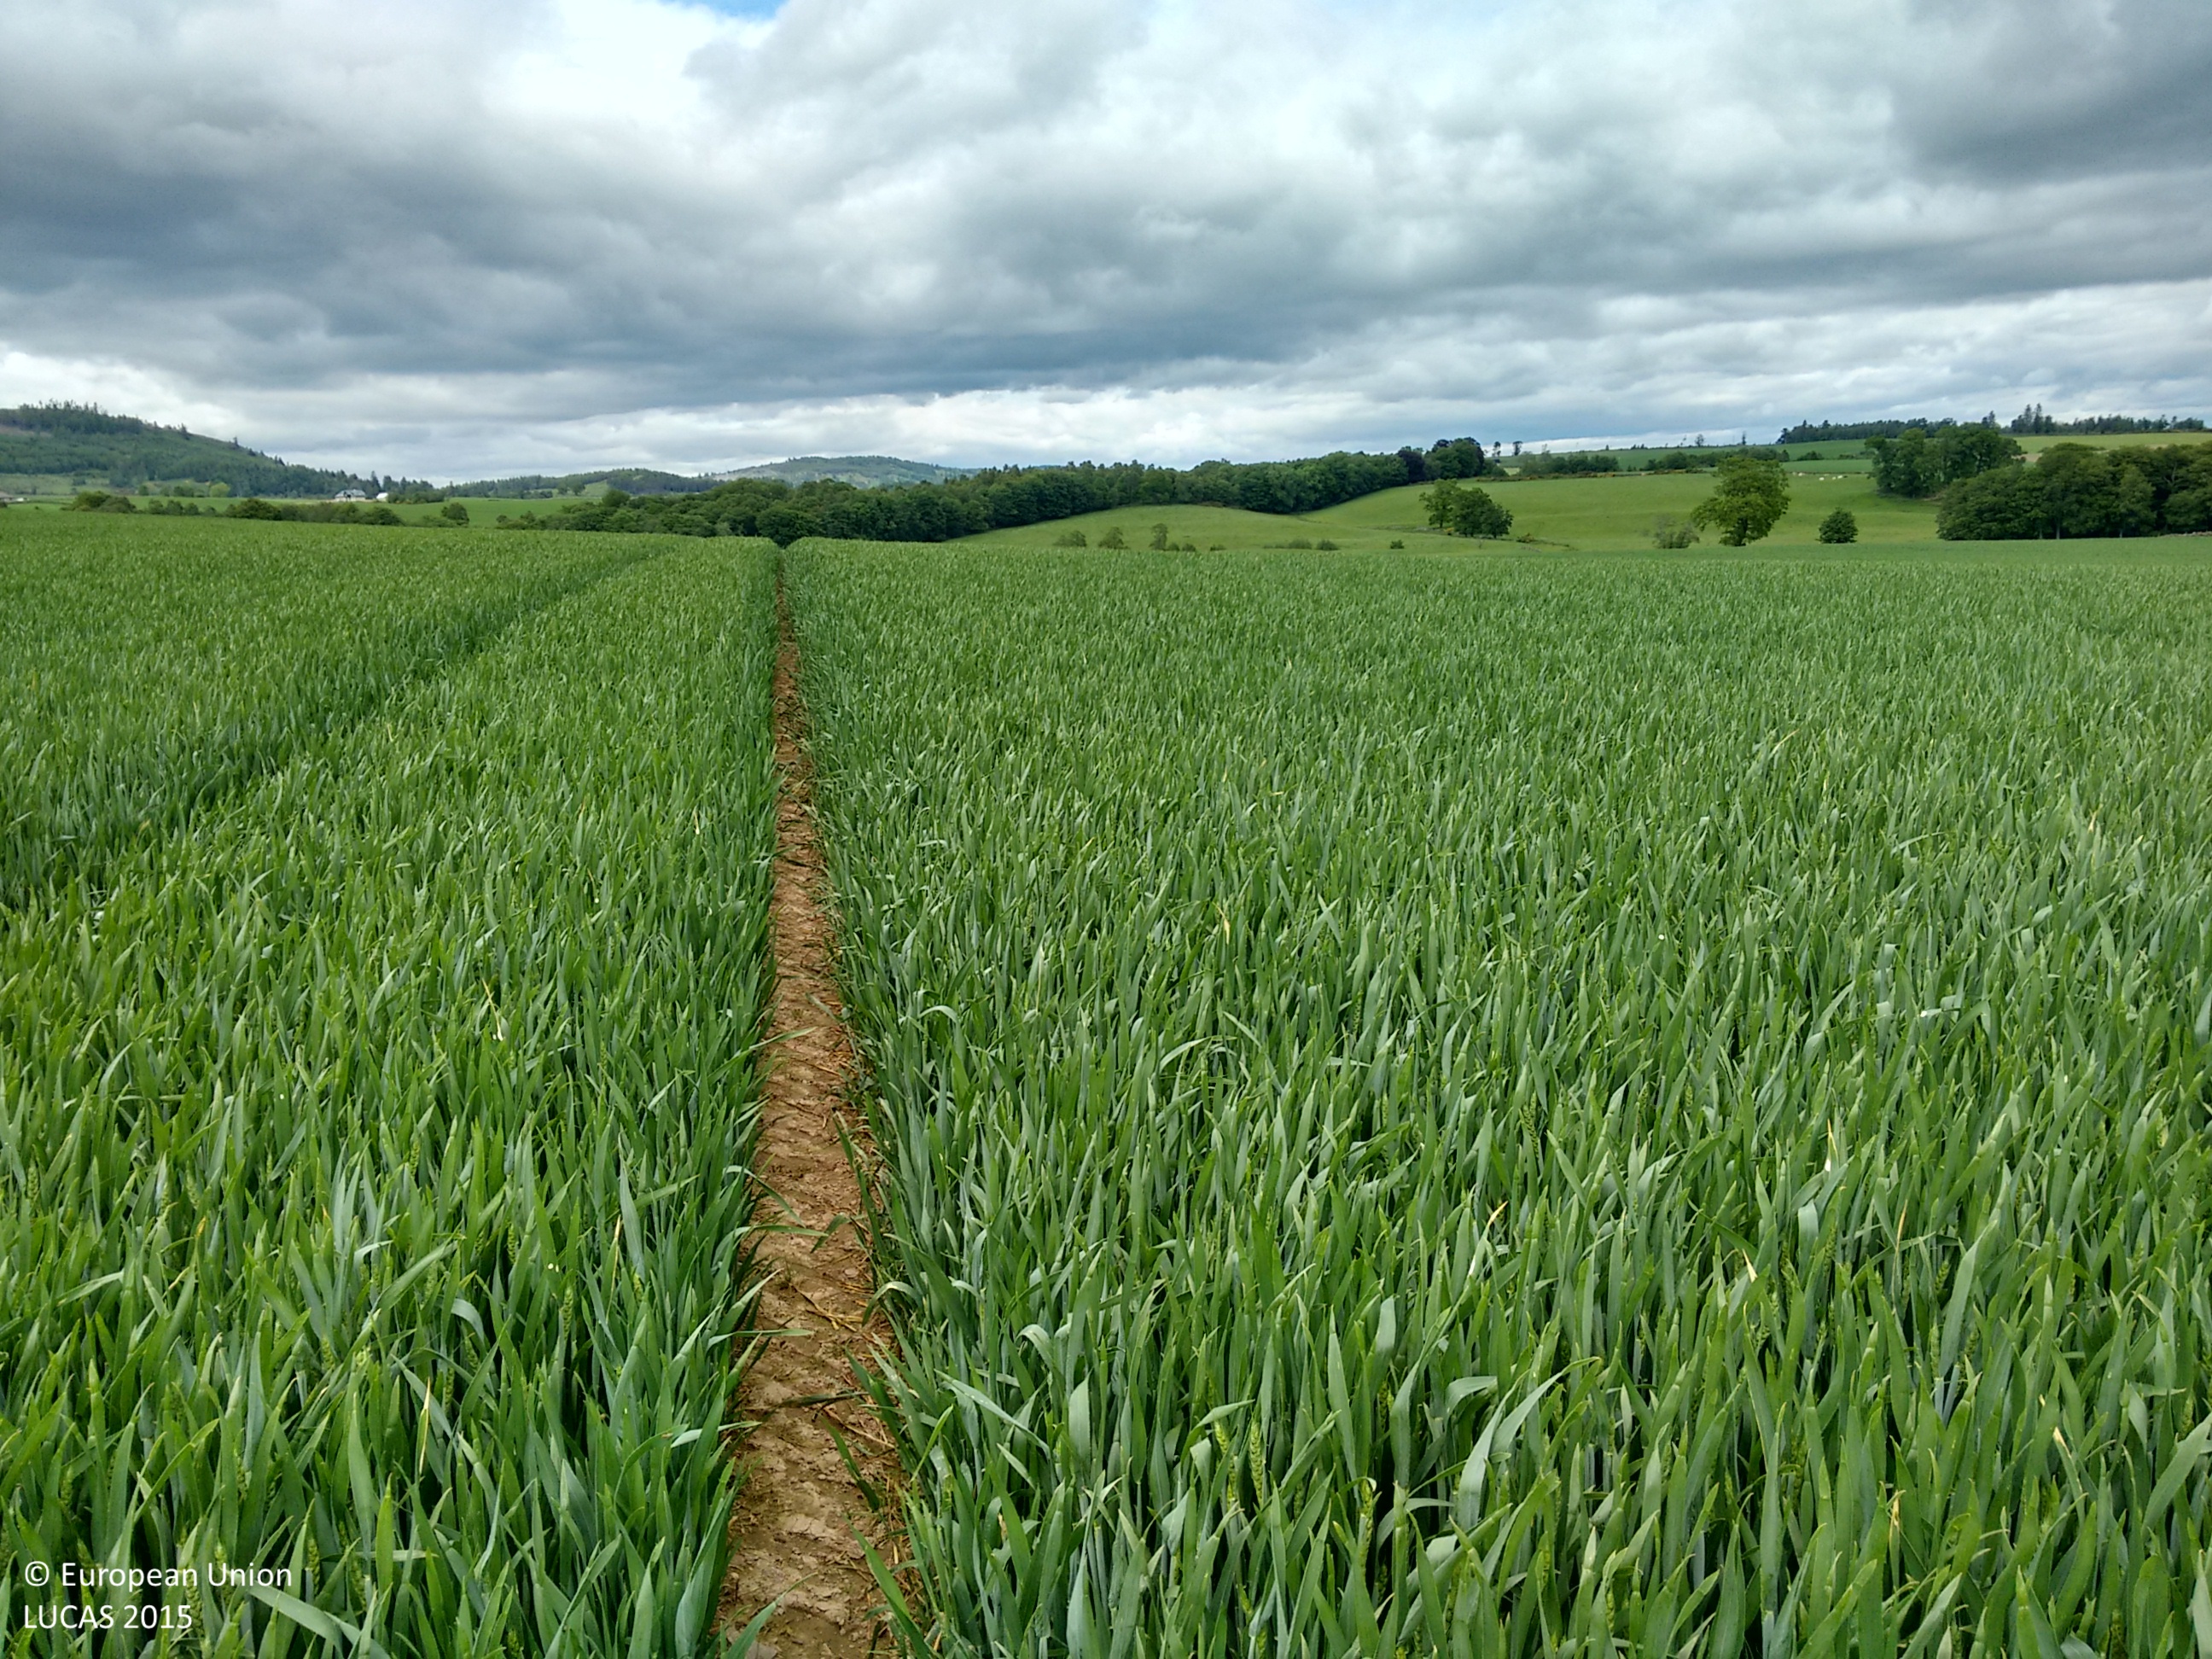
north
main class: Cropland
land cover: Common wheat
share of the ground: > 75 %
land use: Agriculture (excluding fallow land and kitchen gardens)
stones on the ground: 25 - 50 %
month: June
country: GB
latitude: 56.5061
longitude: -3.5455
